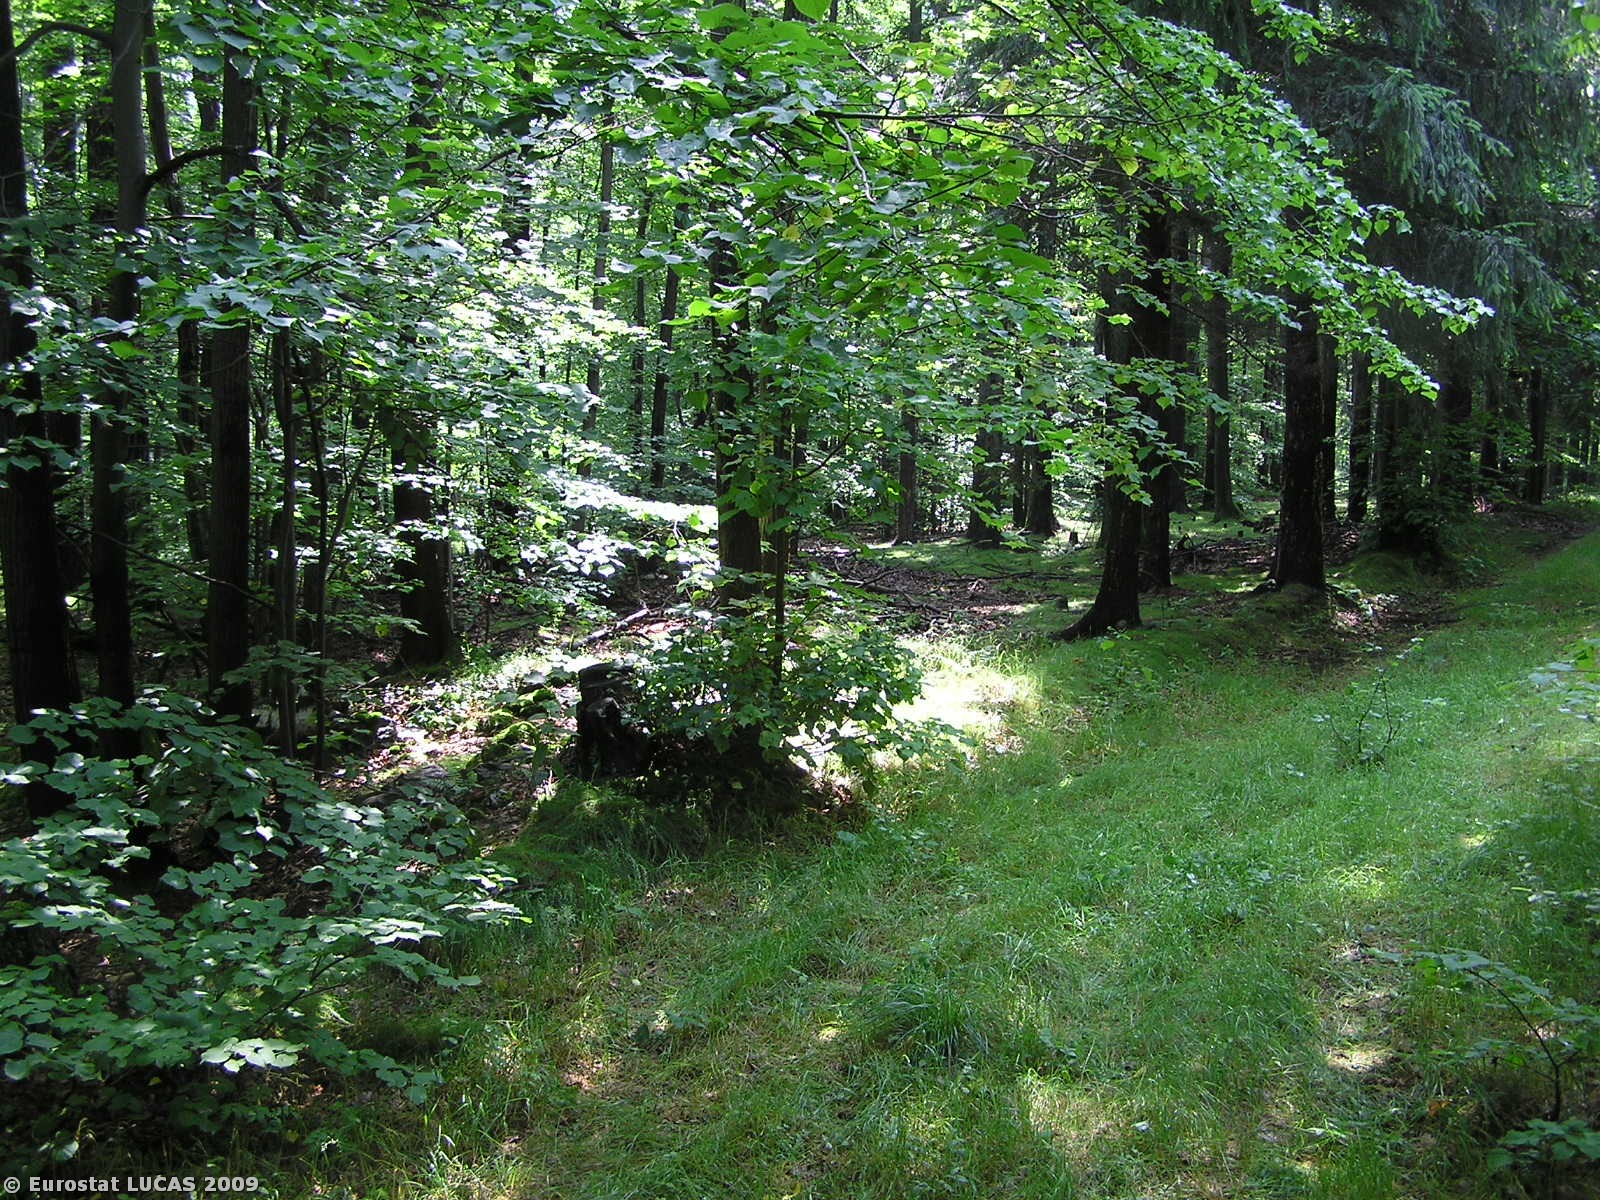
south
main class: Woodland
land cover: Mixed woodland
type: hemiboreal forest and nemoral coniferous forest and mixed broadleaved-coniferous forest
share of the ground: > 75 %
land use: Forestry
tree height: > 5 m
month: June
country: CZ
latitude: 50.2253
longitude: 17.5116
